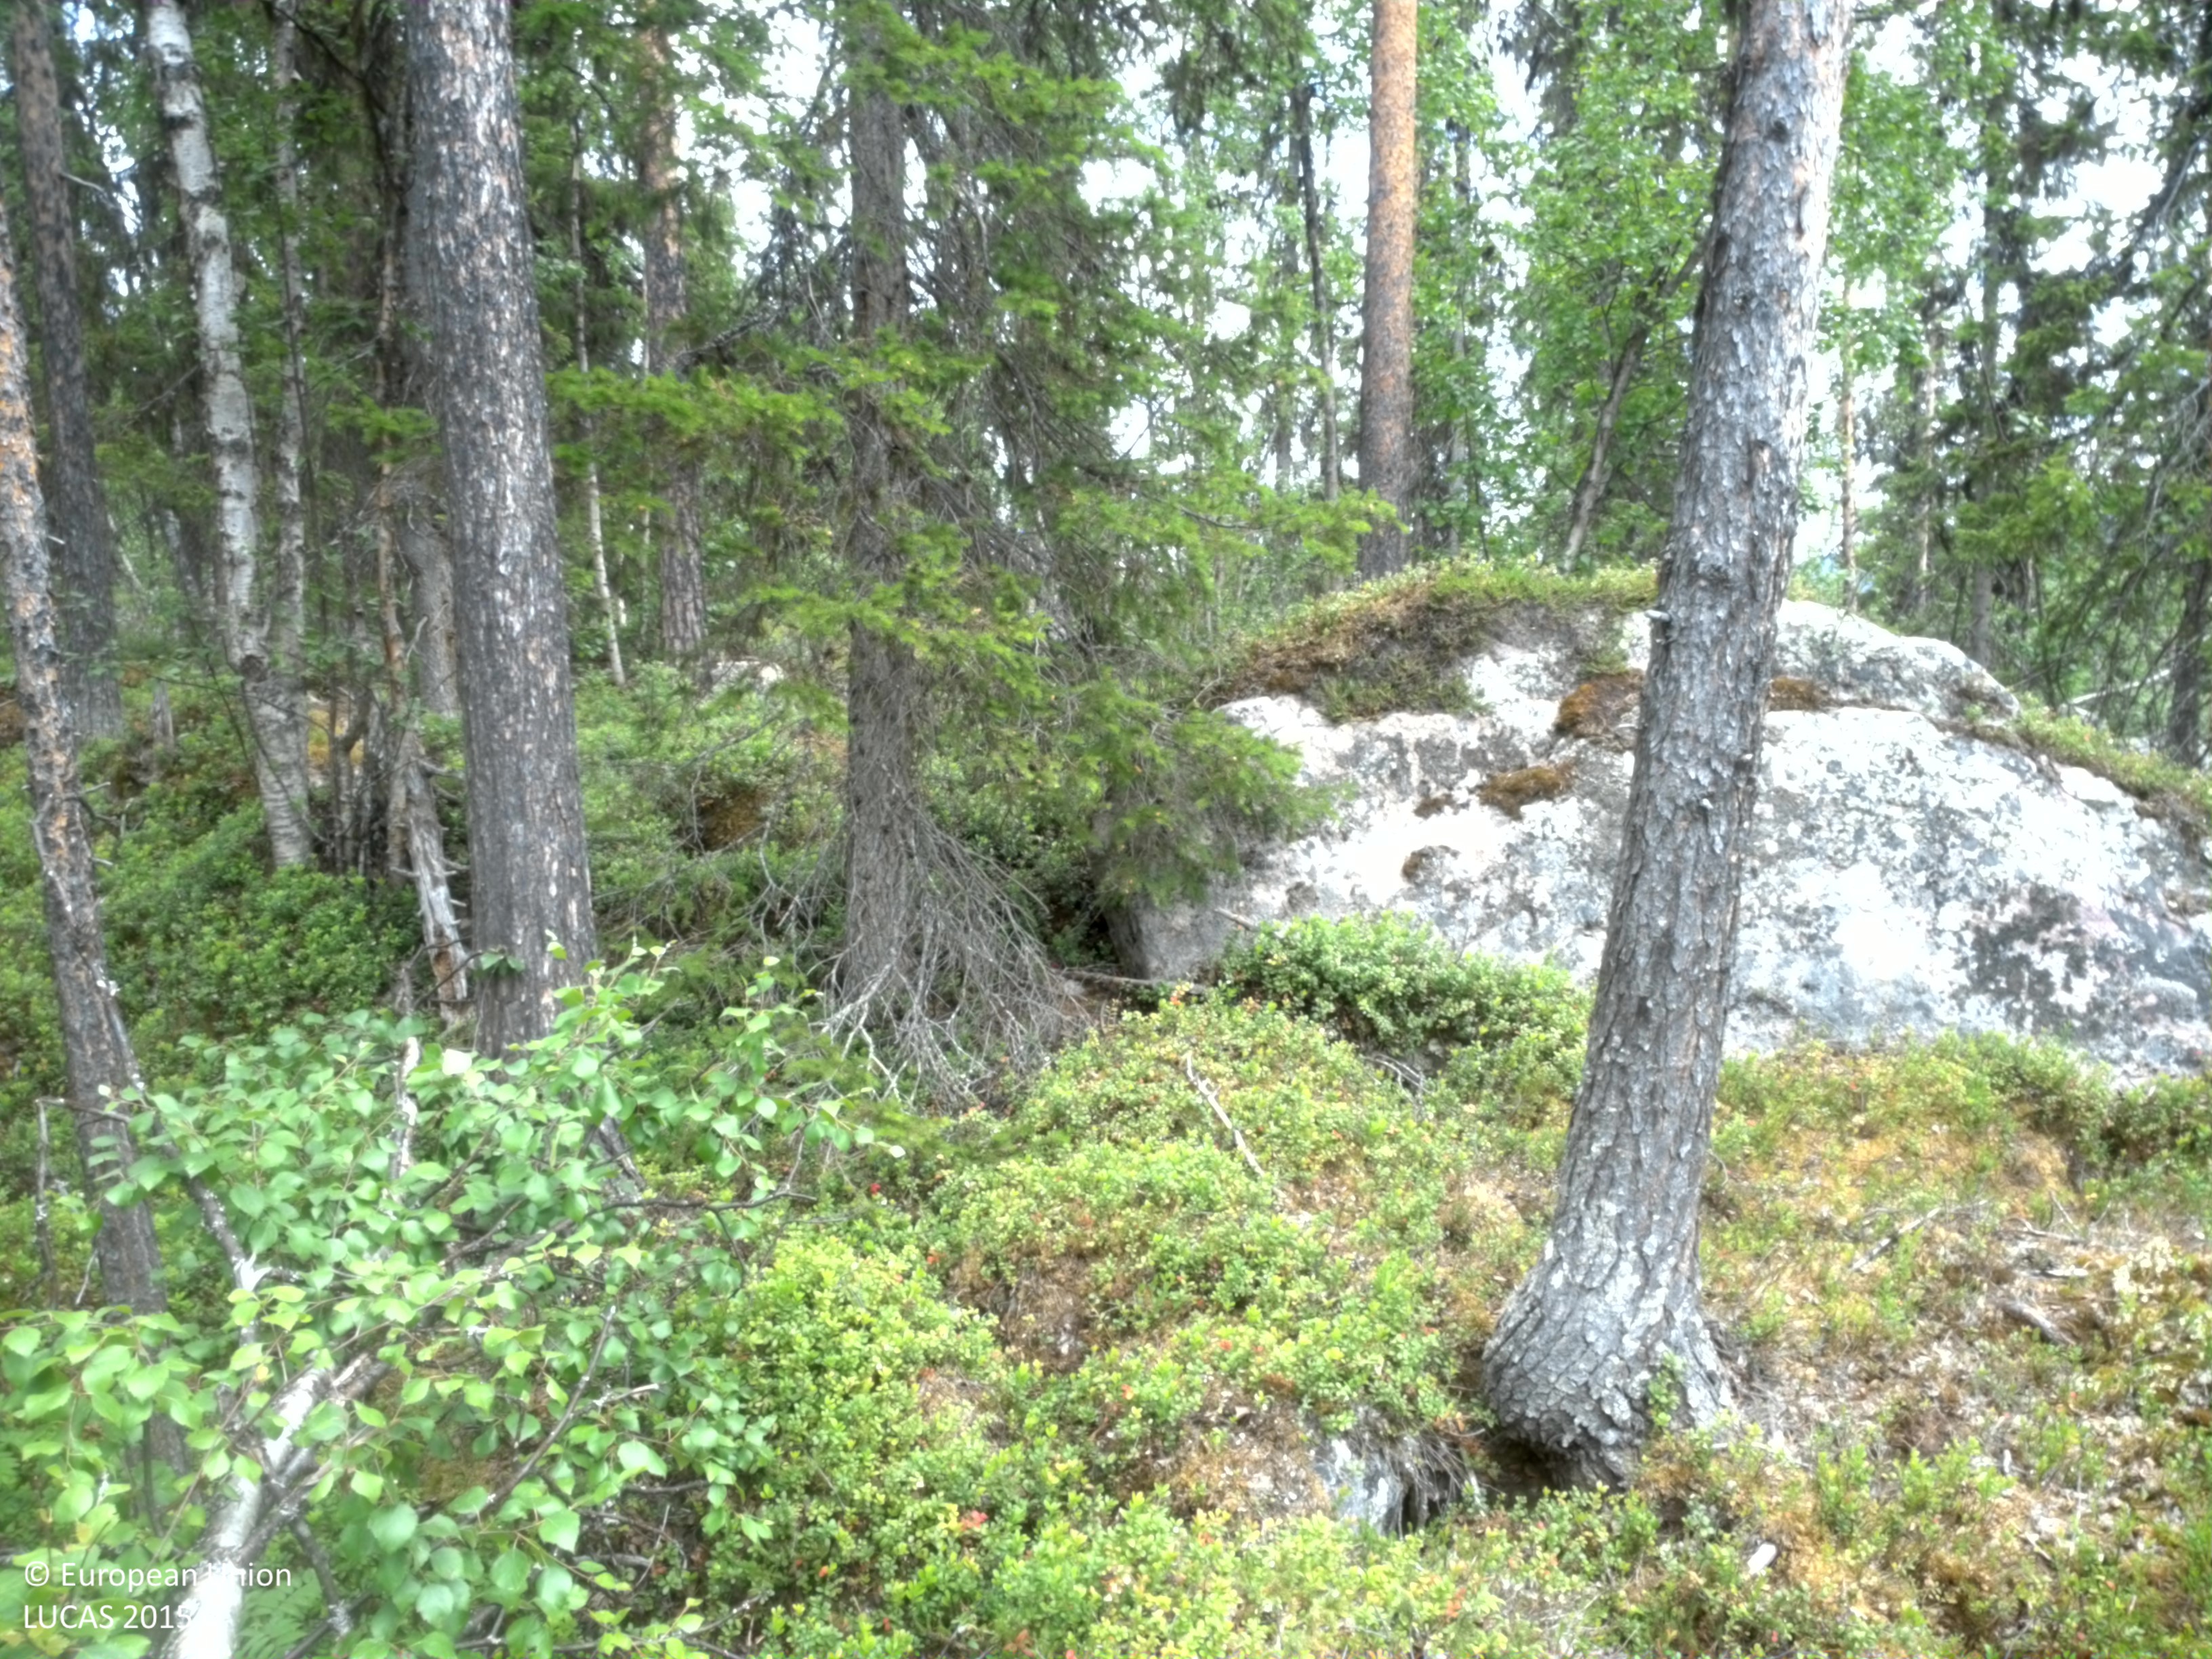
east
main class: Woodland
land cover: Pine dominated coniferous woodland
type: boreal forest
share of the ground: 25 - 50 %
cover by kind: shrubs 50 %, coniferous forest trees 35 %, consolidated bare surface 10 %, broadleaved forest trees 5 %
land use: Forestry
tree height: > 5 m
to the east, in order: Pine dominated coniferous woodland; Spruce dominated mixed woodland; Tracks; Spruce dominated mixed woodland; Broadleaved woodland; Pine dominated mixed woodland; Rocks and stones; Pine dominated mixed woodland; Rocks and stones; Pine dominated mixed woodland
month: July
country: SE
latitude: 66.8929
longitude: 18.2819
